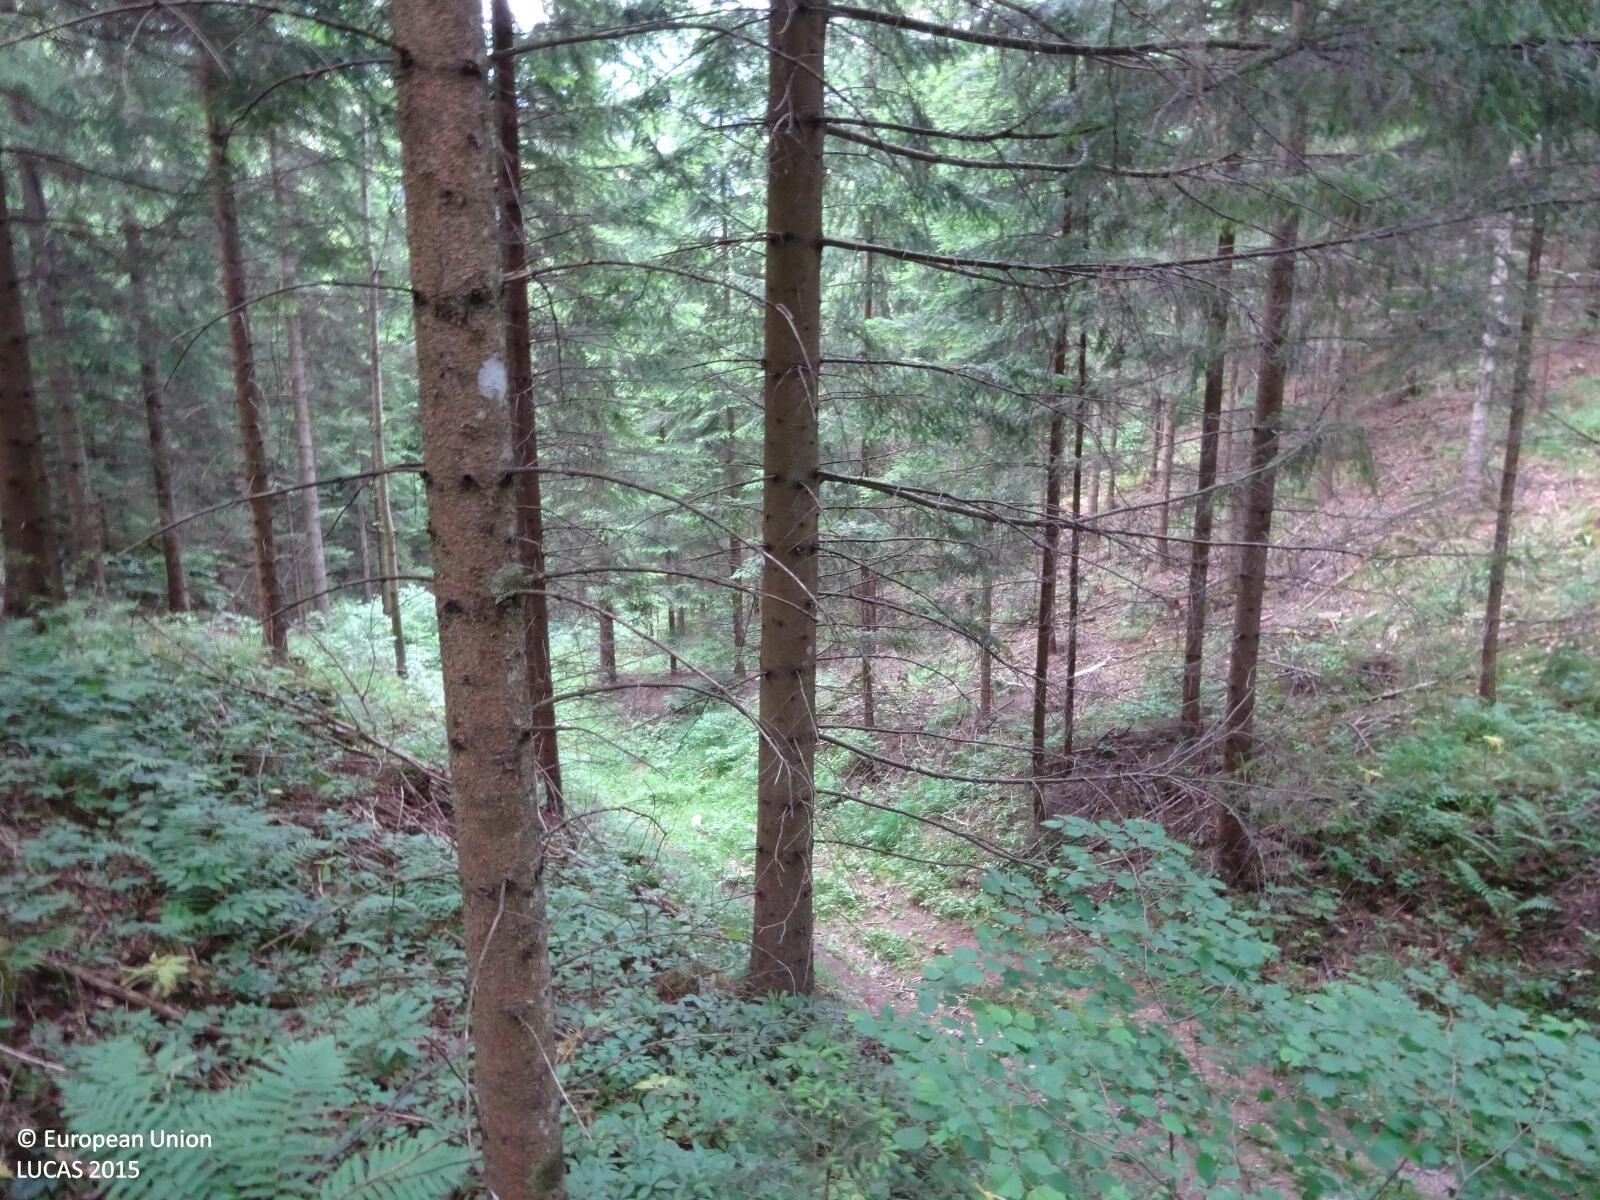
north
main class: Woodland
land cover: Spruce dominated coniferous woodland
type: alpine coniferous forest
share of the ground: > 75 %
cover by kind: coniferous forest trees 90 %, broadleaved forest trees 10 %
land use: Forestry
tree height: > 5 m
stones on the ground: < 10 %
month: June
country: AT
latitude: 47.6548
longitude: 15.8204
